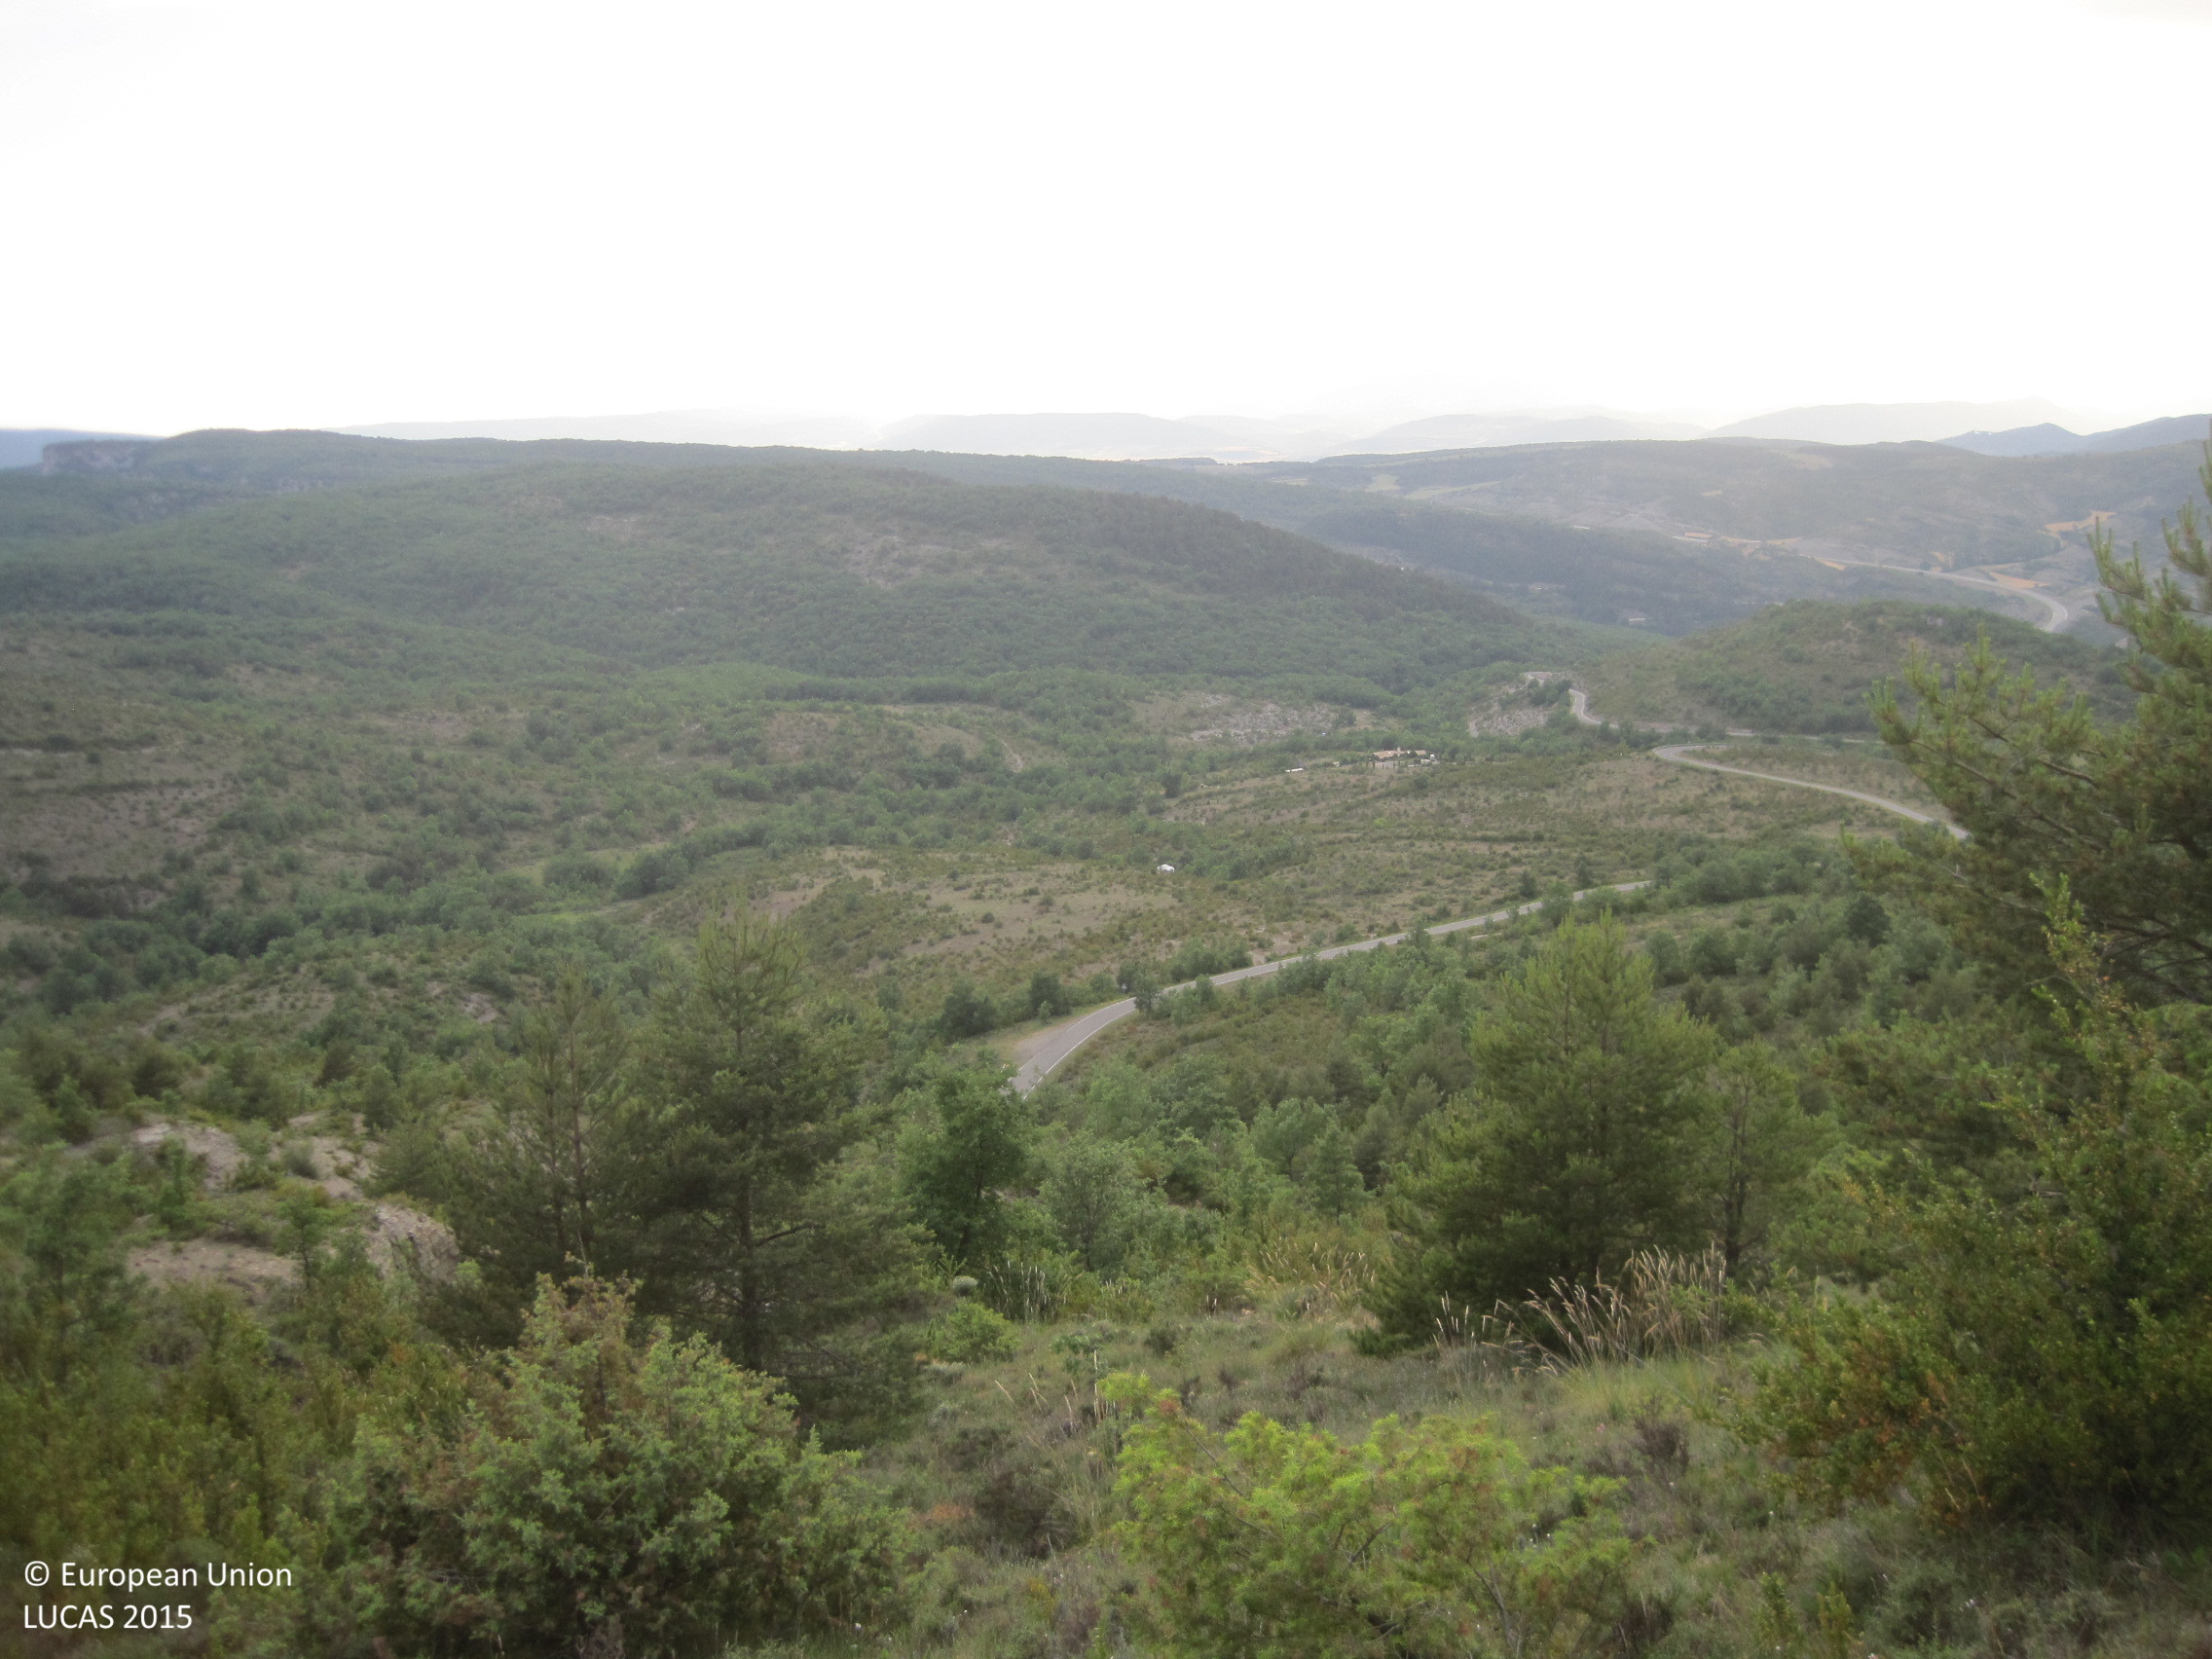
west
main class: Shrubland
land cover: Shrubland without tree cover
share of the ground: > 75 %
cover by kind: herbaceous plants 60 %, shrubs 40 %
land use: Semi-natural and natural areas not in use
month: June
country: ES
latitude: 42.6917
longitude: -1.1528
